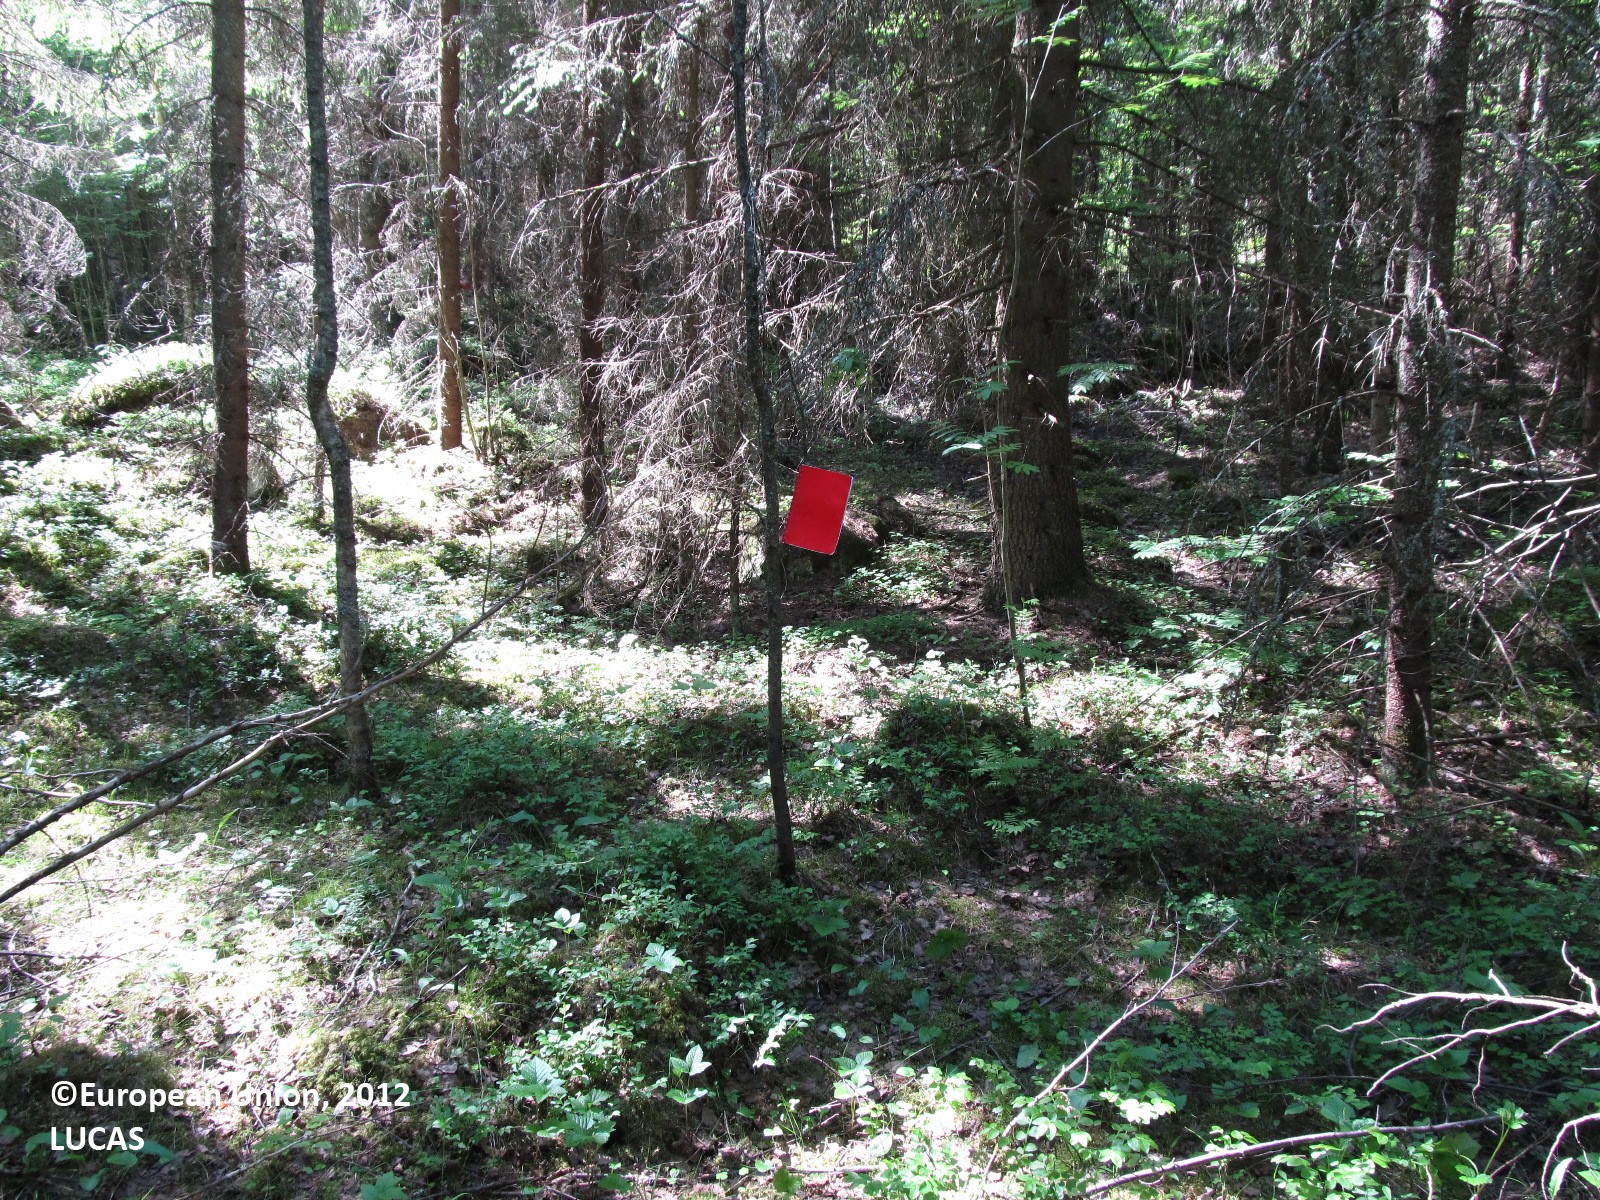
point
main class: Woodland
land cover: Spruce dominated coniferous woodland
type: boreal forest
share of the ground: 50 - 75 %
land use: Forestry
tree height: > 5 m
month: June
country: FI
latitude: 63.0317
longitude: 27.7402
